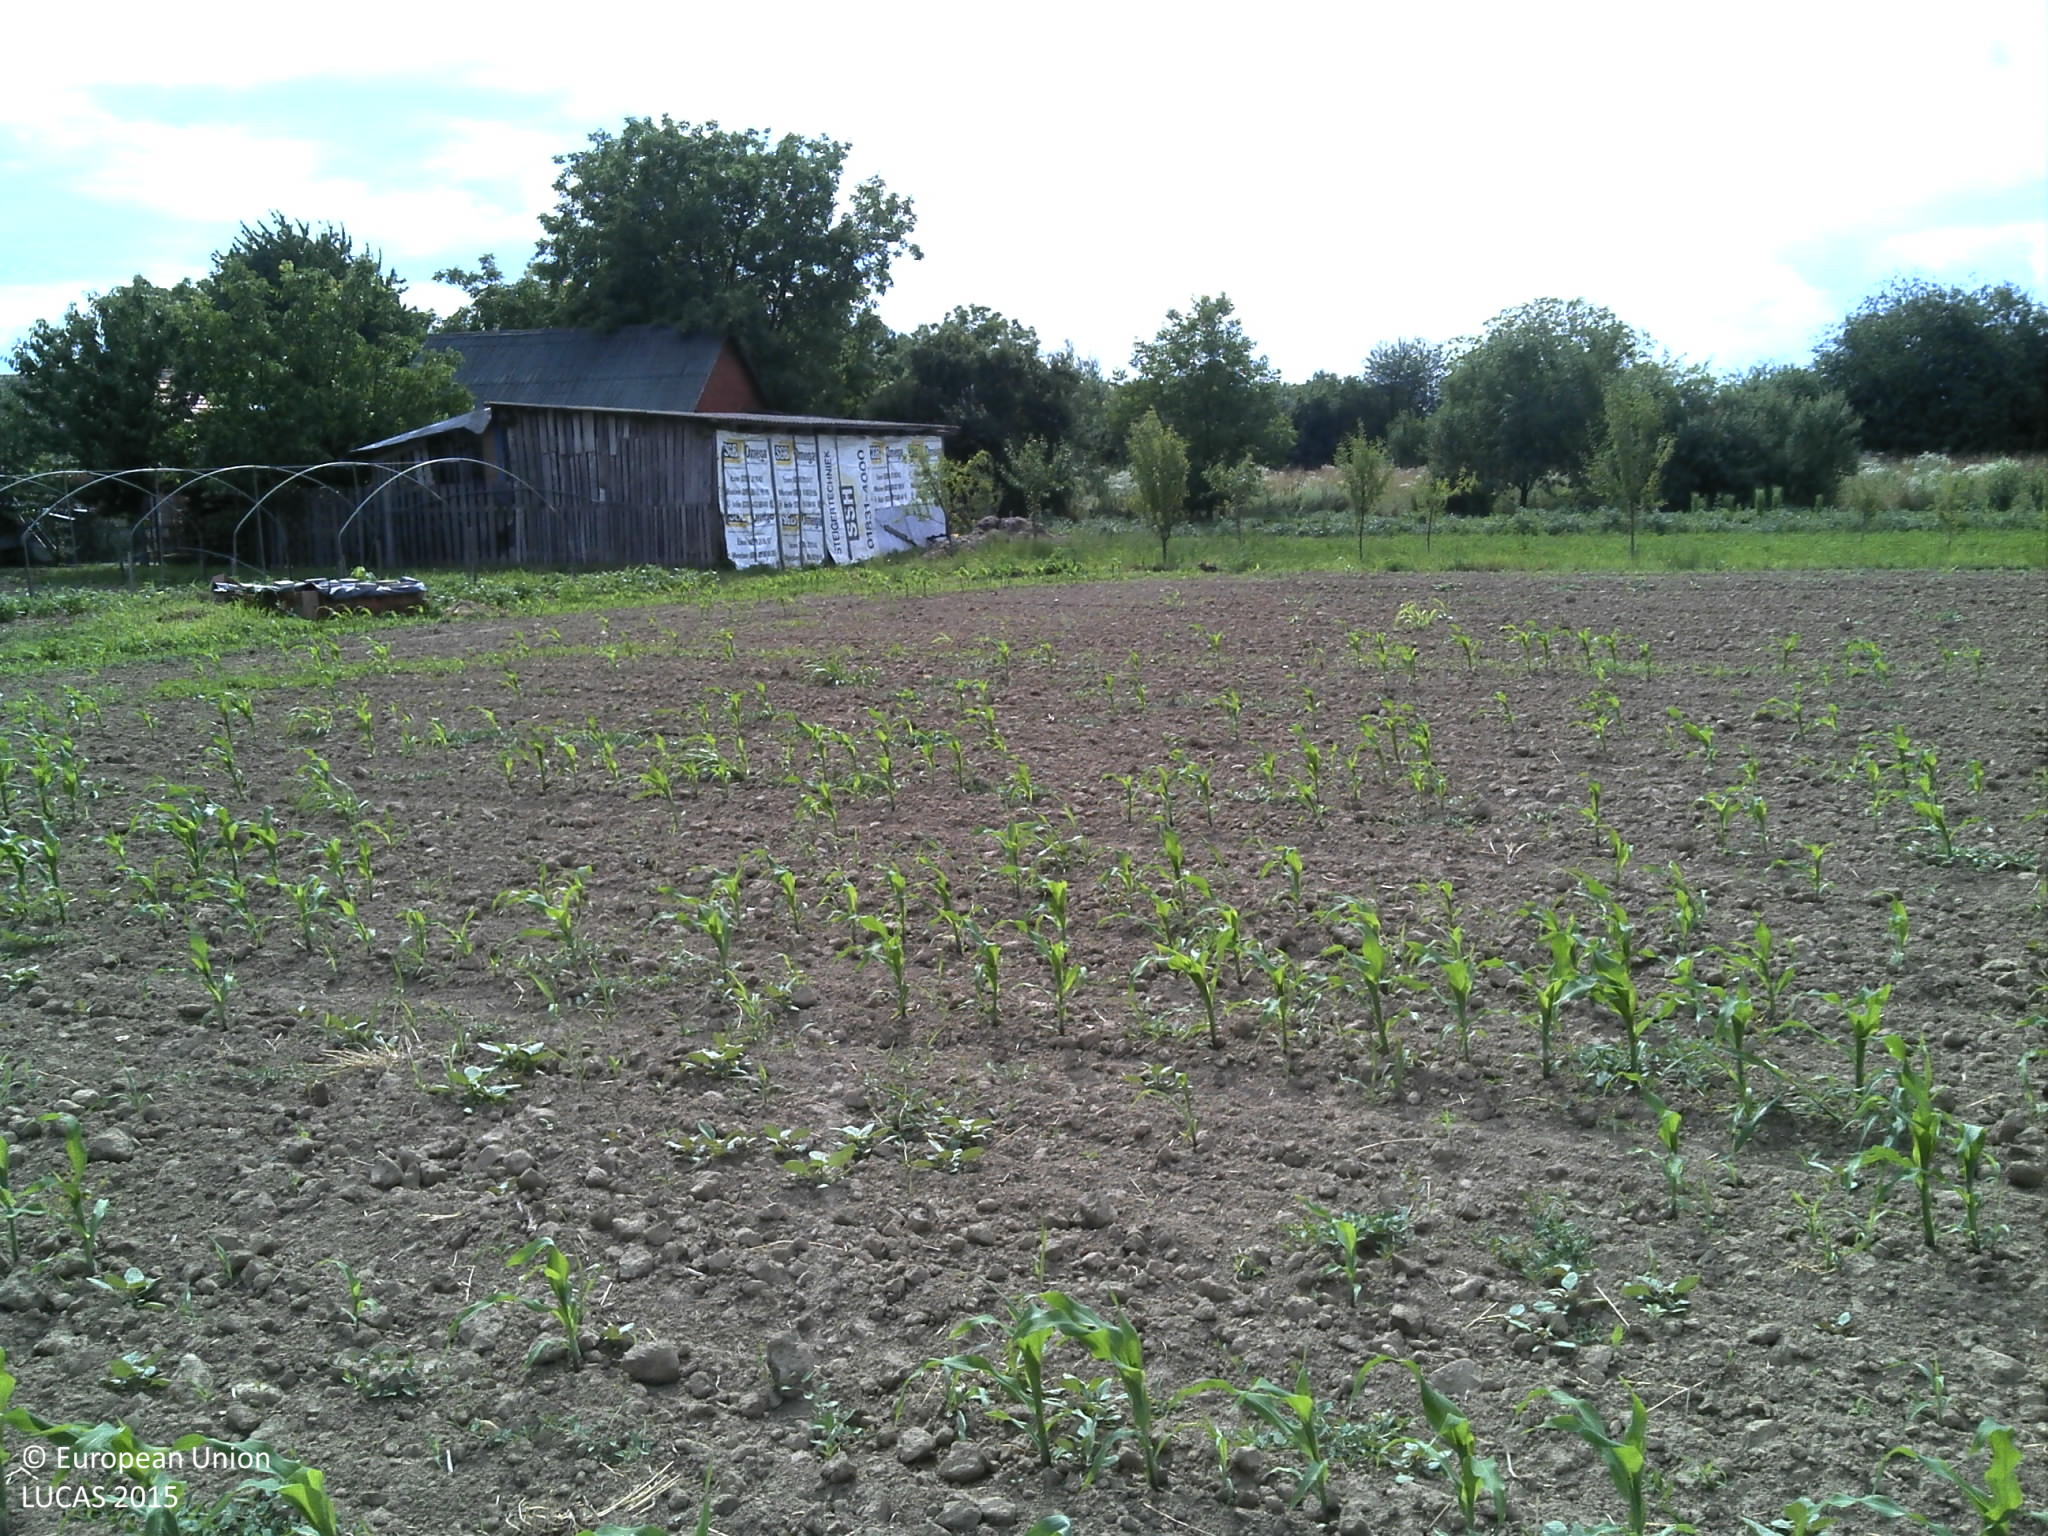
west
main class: Cropland
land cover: Maize
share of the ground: 10 - 25 %
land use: Agriculture (excluding fallow land and kitchen gardens)
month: June
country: HR
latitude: 45.3848
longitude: 18.4219
